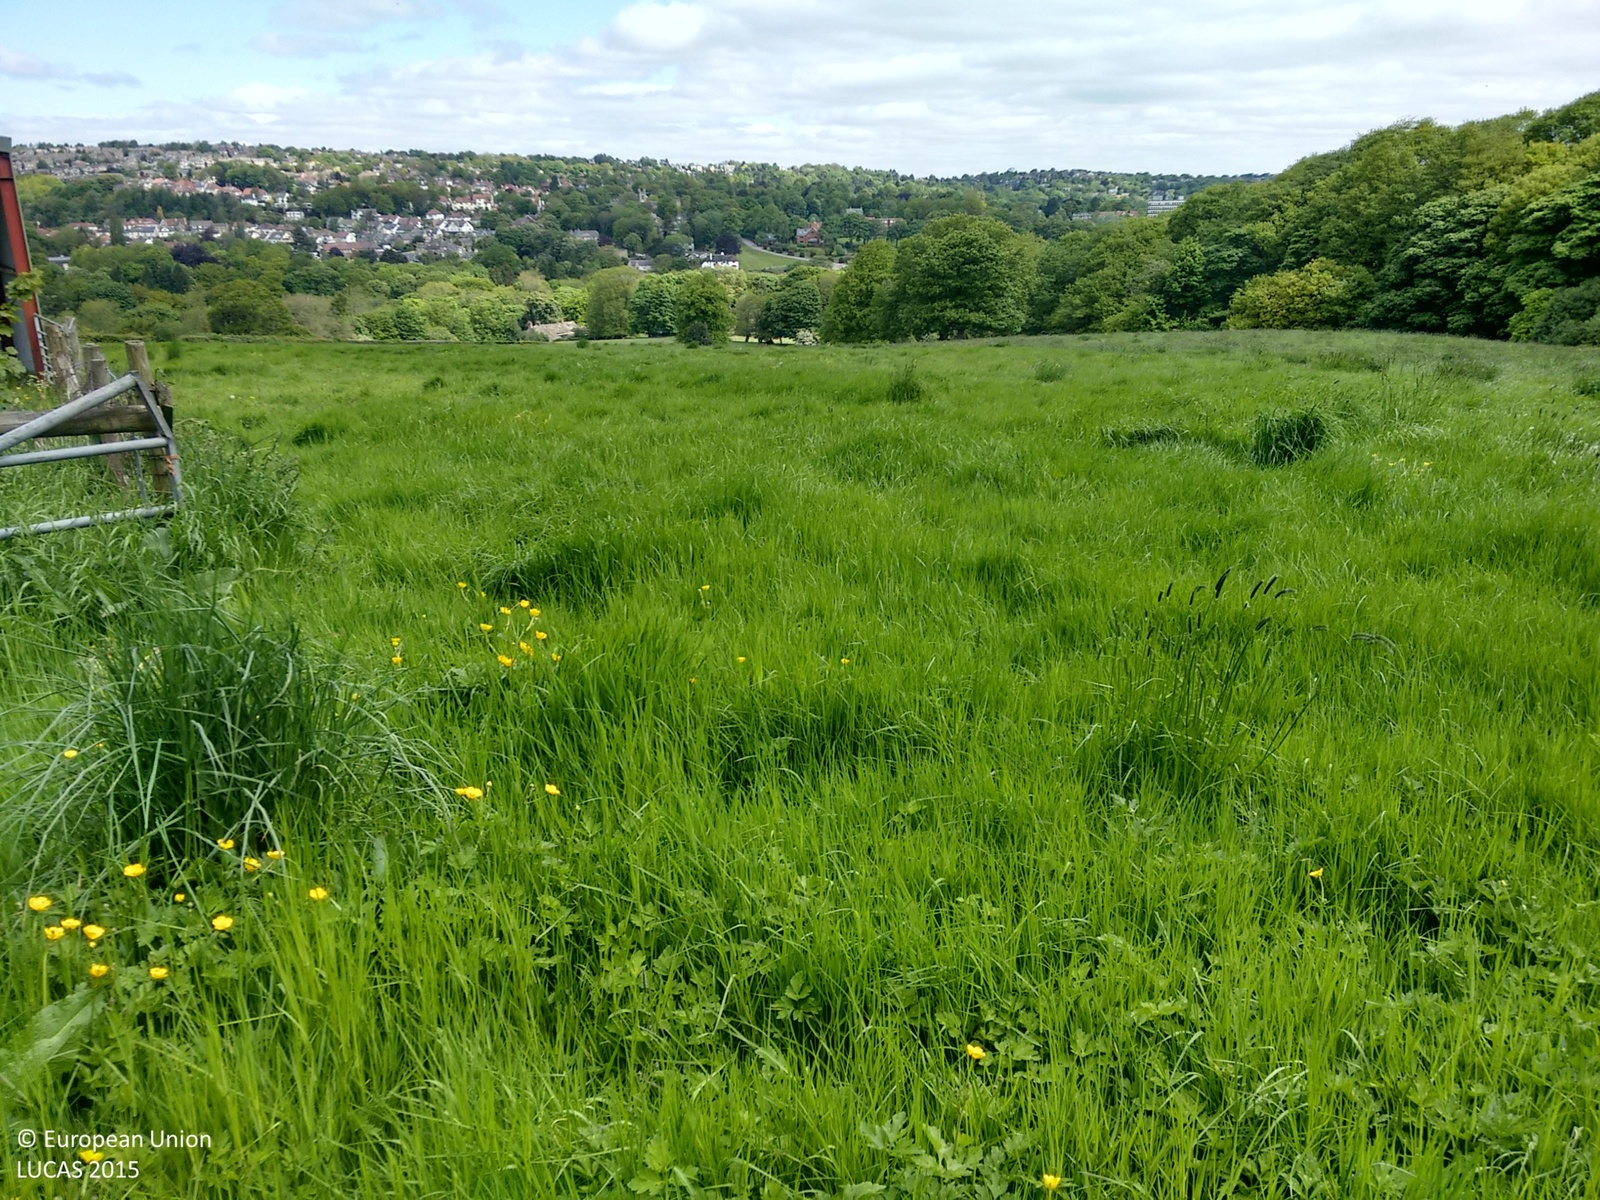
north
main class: Grassland
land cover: Grassland without tree/shrub cover
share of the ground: > 75 %
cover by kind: herbaceous plants 100 %
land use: Agriculture (excluding fallow land and kitchen gardens)
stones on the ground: < 10 %
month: May
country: GB
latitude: 53.3564
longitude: -1.5448
